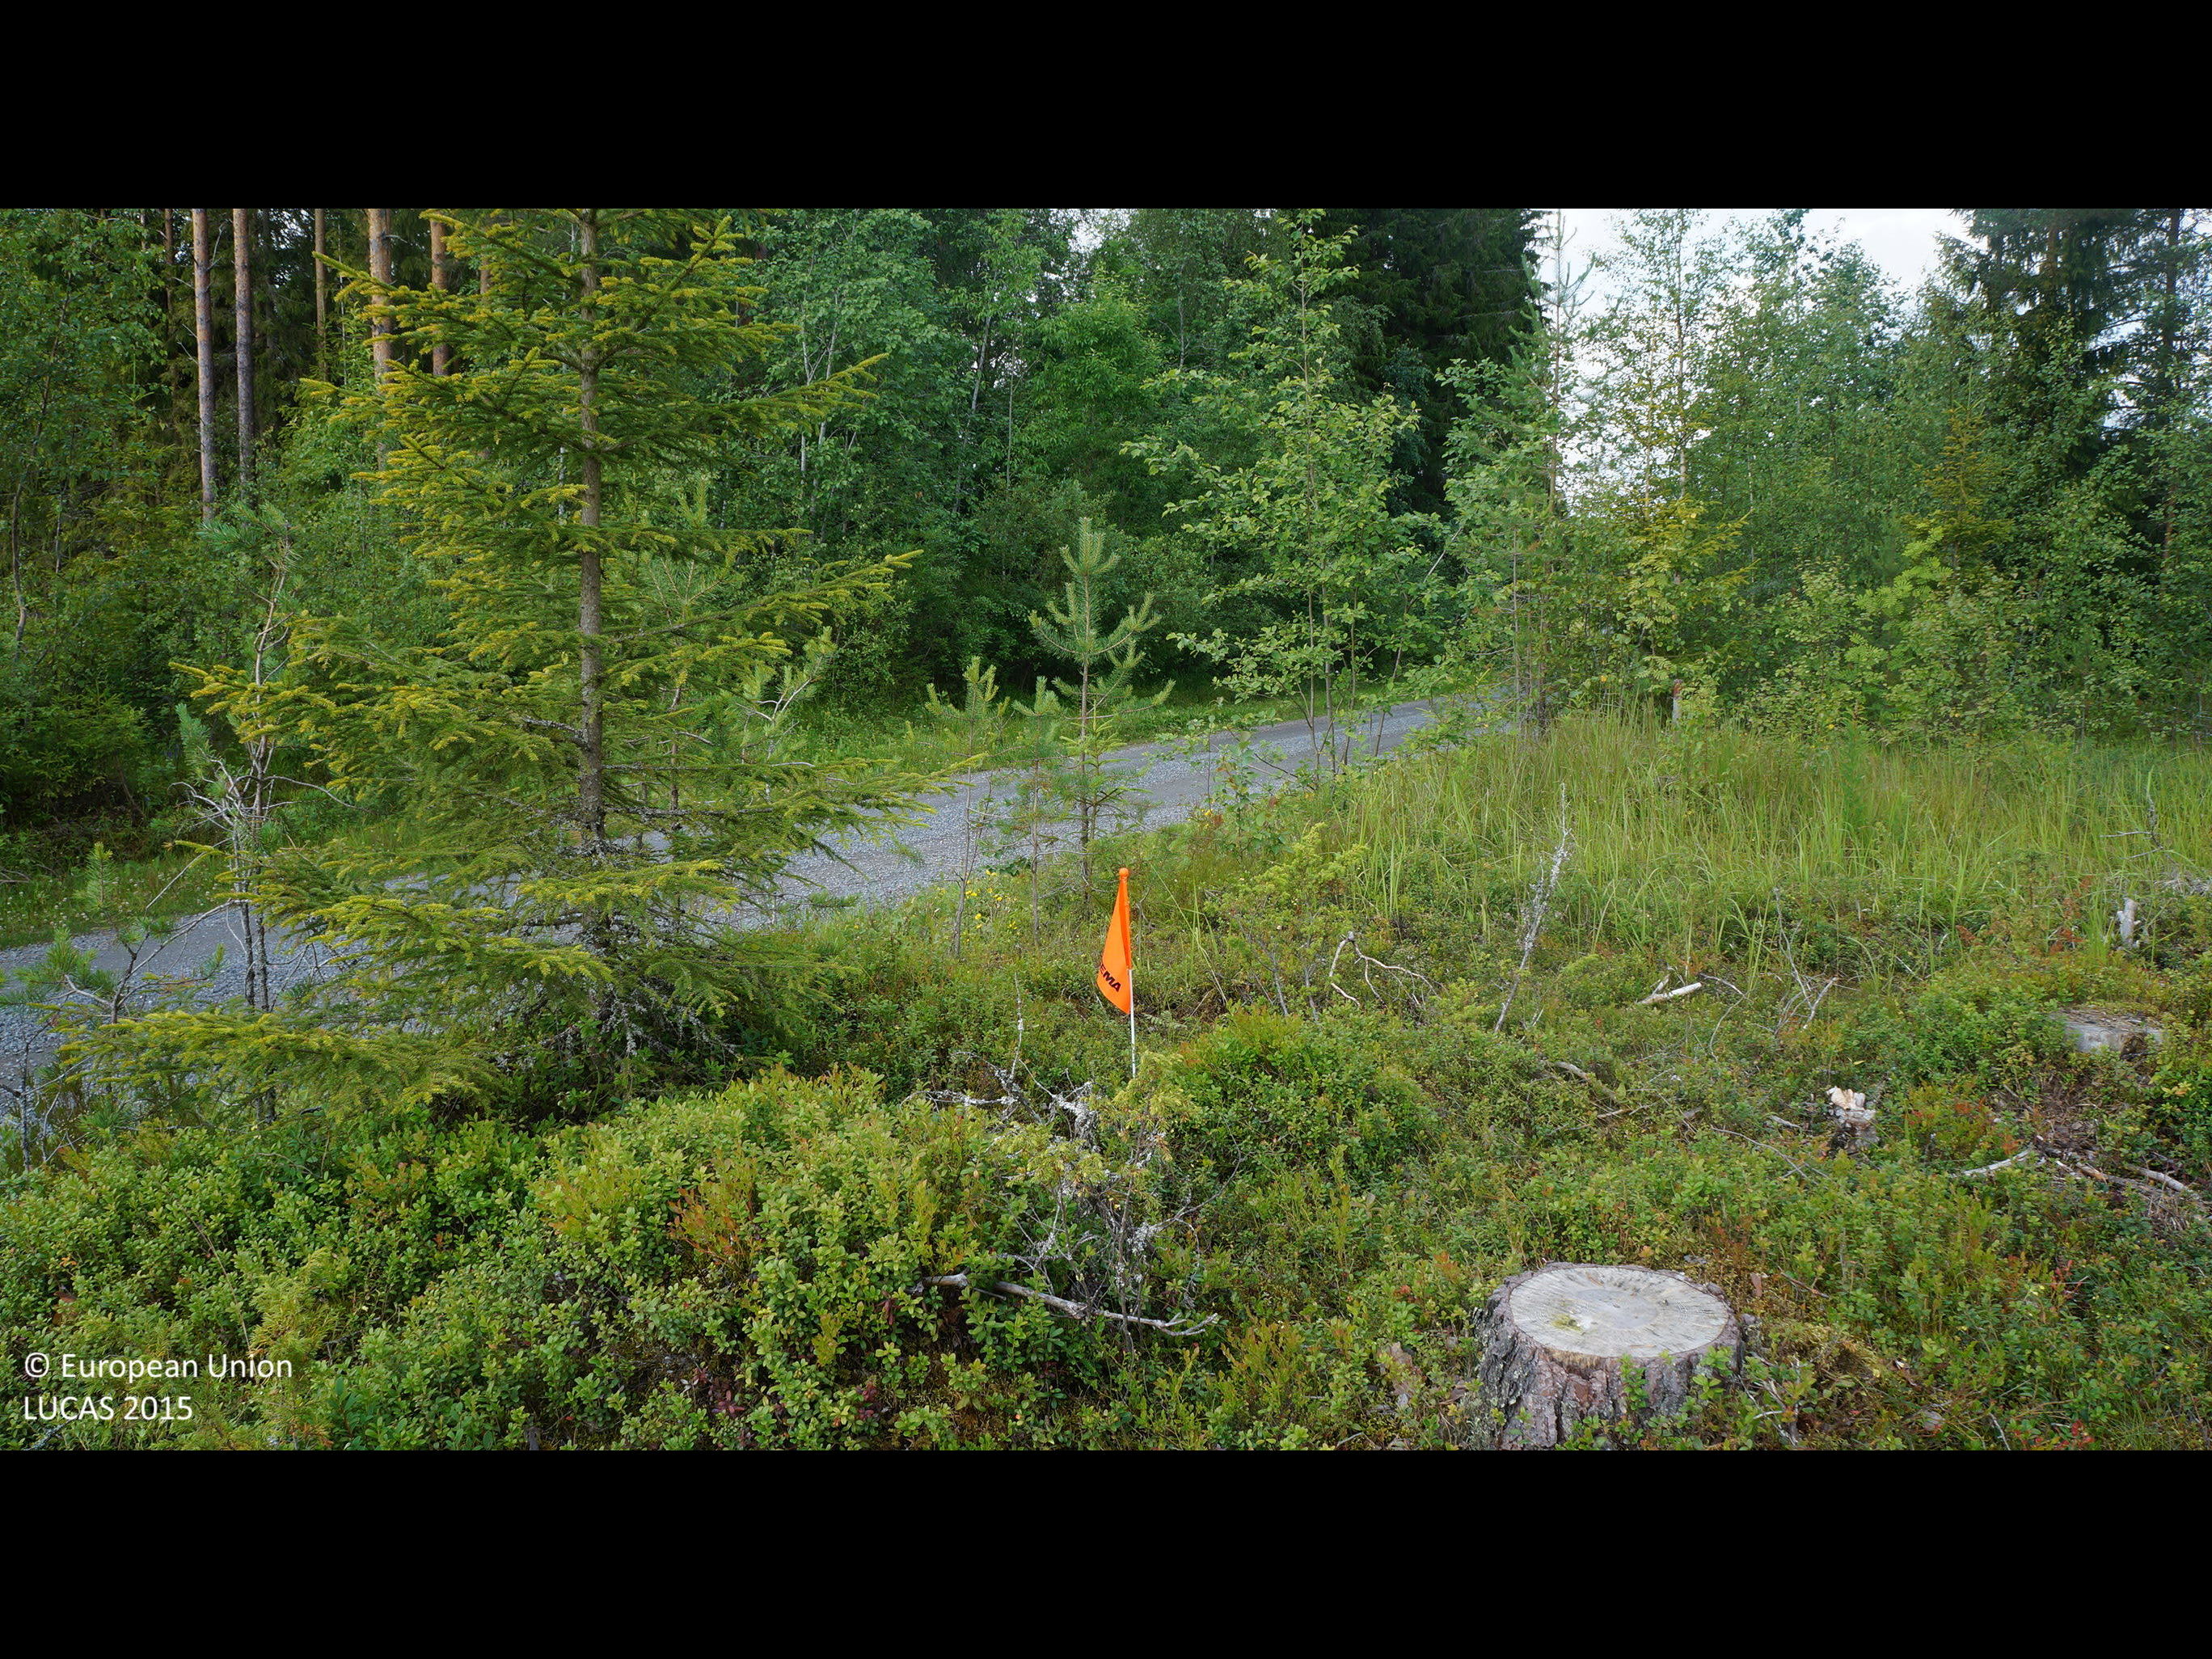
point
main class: Woodland
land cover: Pine dominated coniferous woodland
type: boreal forest
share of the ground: 10 - 25 %
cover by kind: shrubs 80 %, coniferous forest trees 10 %, herbaceous plants 5 %, lichens and mosses 5 %
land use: Forestry
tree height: > 5 m
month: July
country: FI
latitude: 64.1110
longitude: 24.3368
